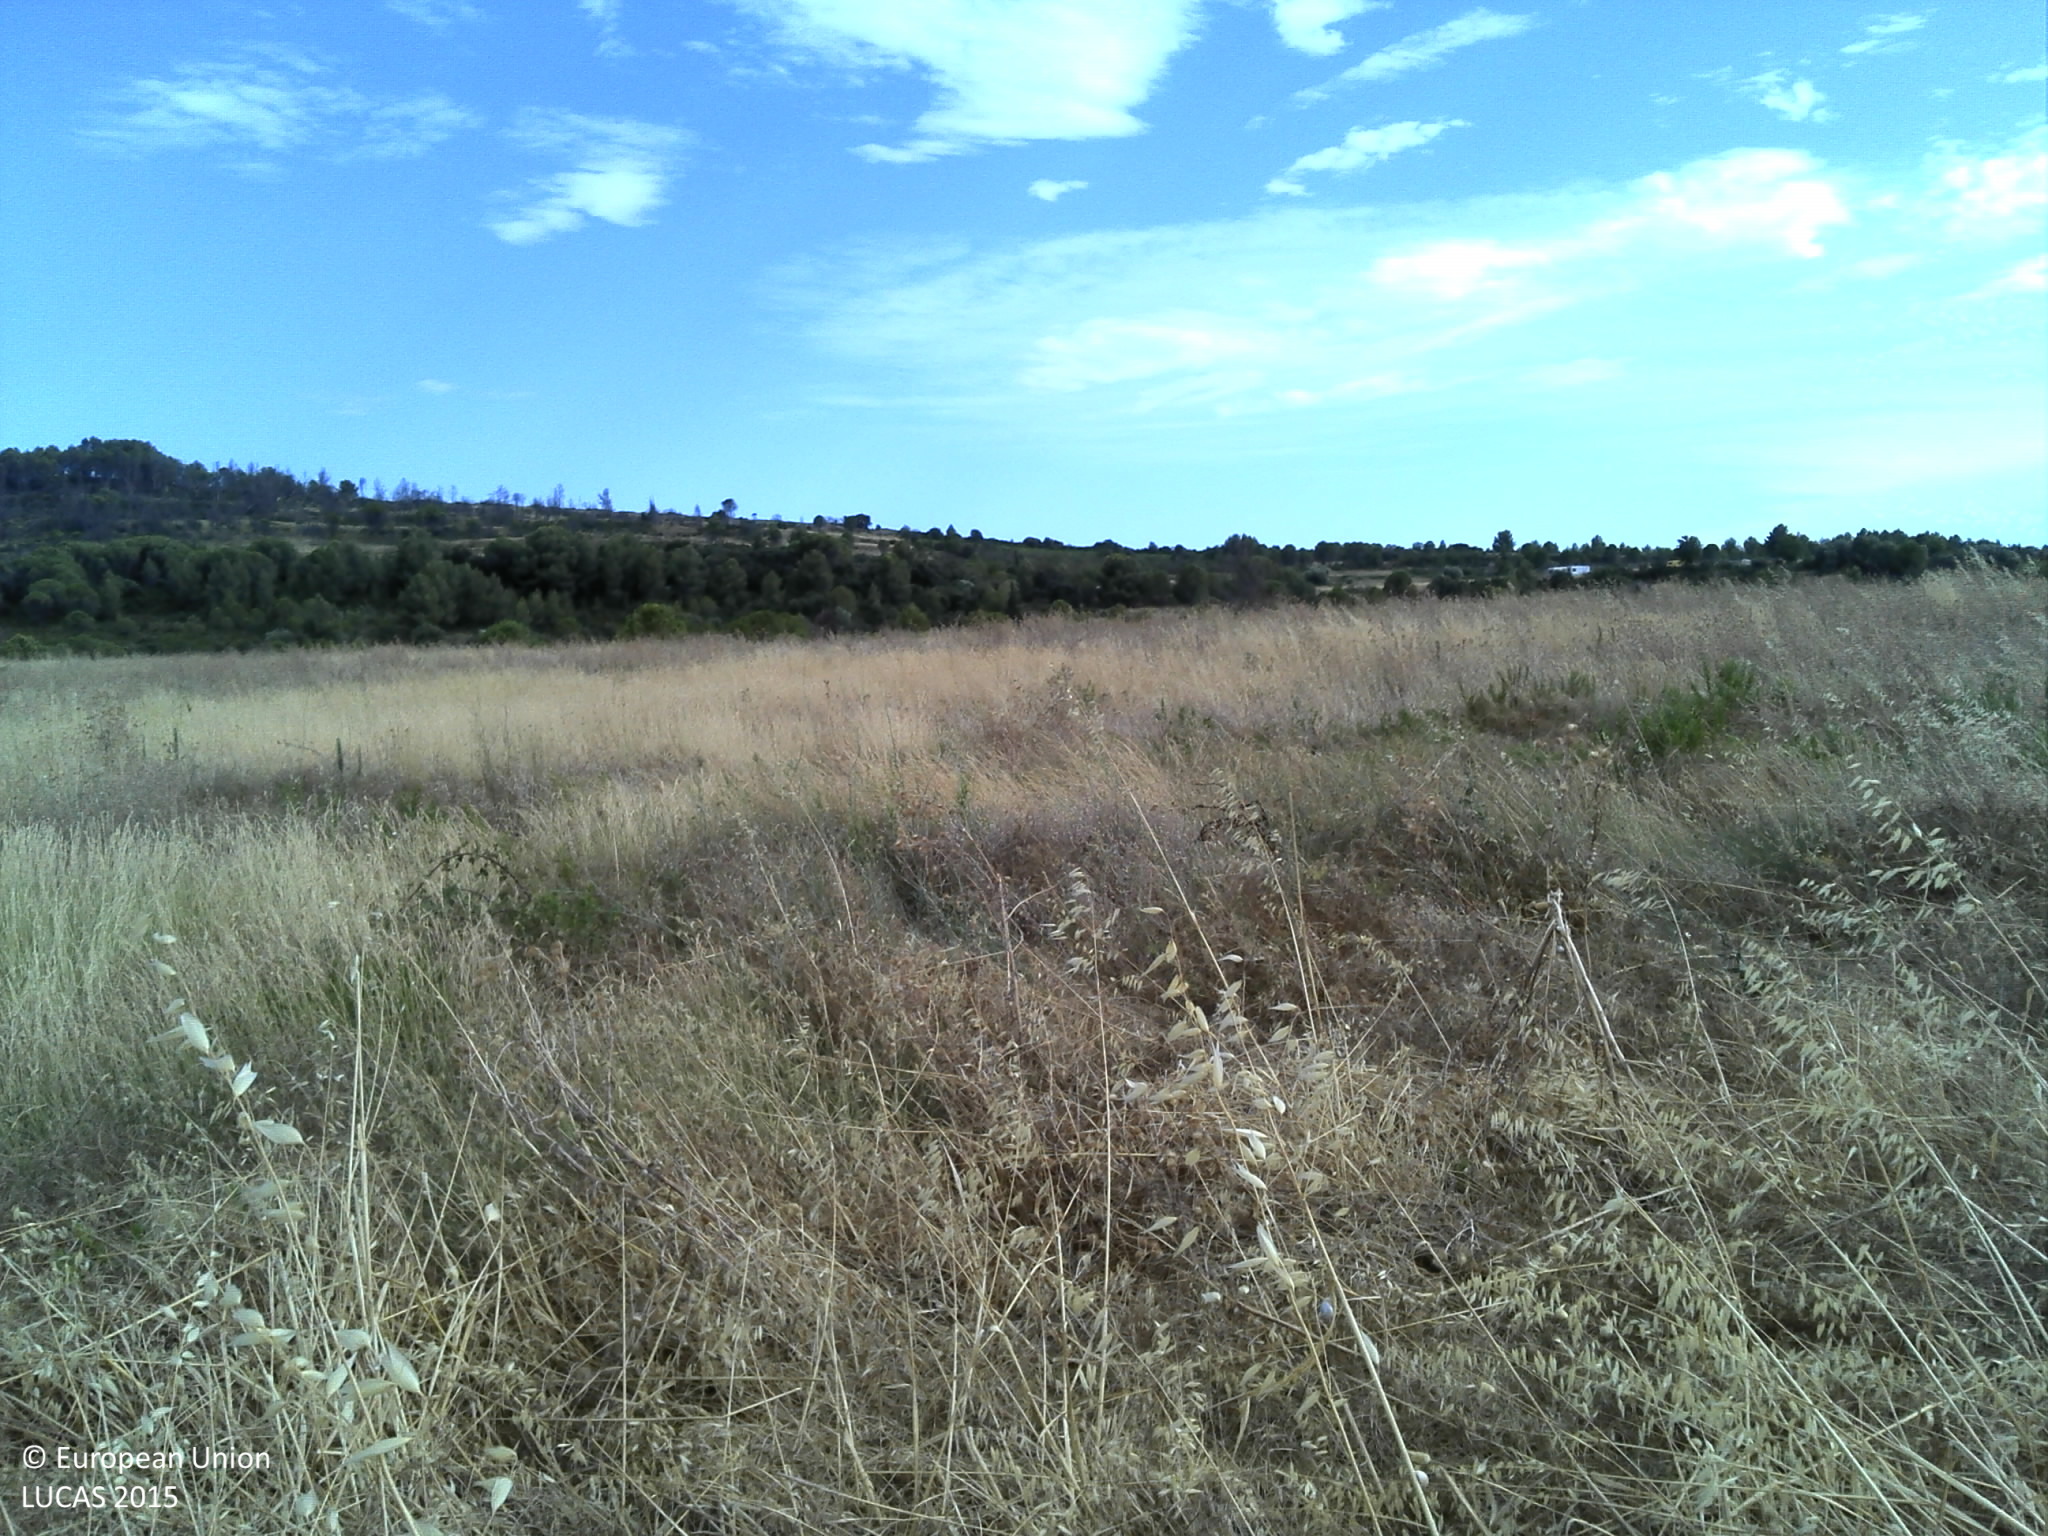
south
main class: Grassland
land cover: Spontaneously vegetated surfaces
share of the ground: > 75 %
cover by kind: herbaceous plants 100 %
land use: Fallow land
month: July
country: FR
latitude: 43.5190
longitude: 3.5885
